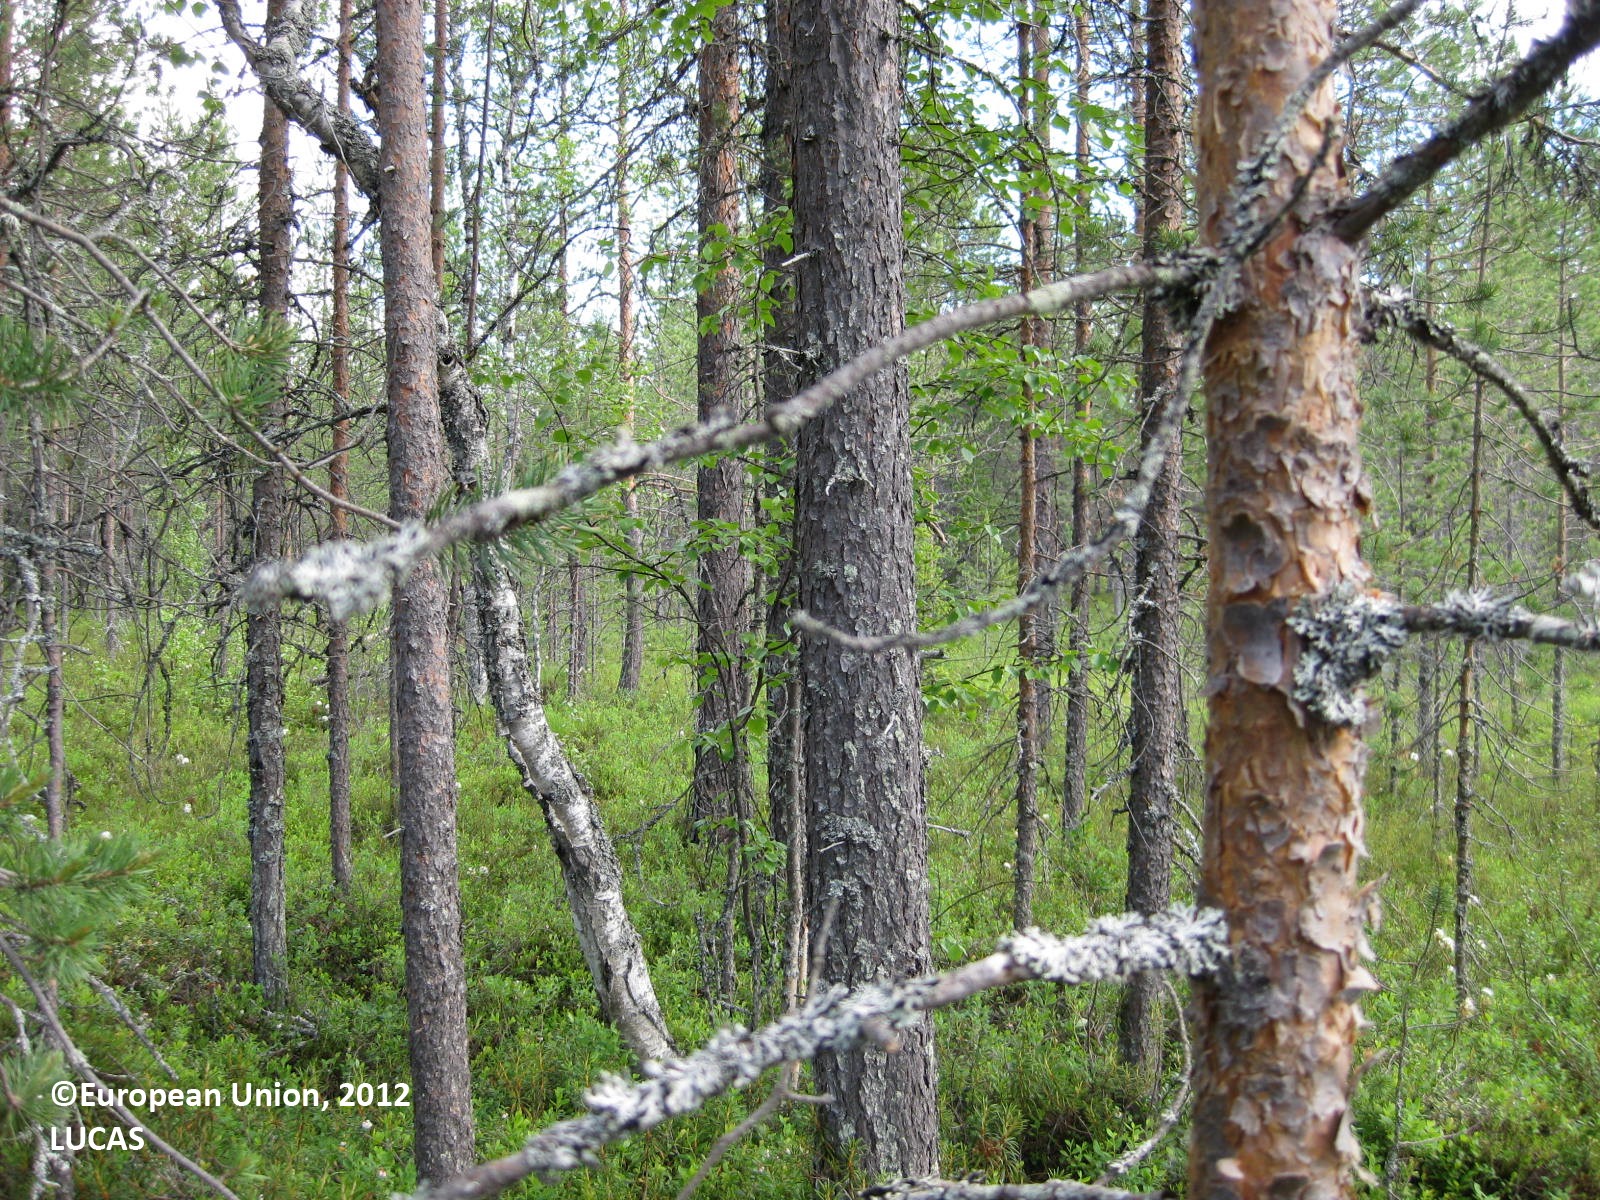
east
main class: Woodland
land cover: Pine dominated coniferous woodland
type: boreal forest
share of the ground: 50 - 75 %
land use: Forestry
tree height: > 5 m
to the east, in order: Pine dominated coniferous woodland; Ditches and canals; Pine dominated coniferous woodland; Other coniferous woodland
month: July
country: FI
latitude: 65.4608
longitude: 29.1535
